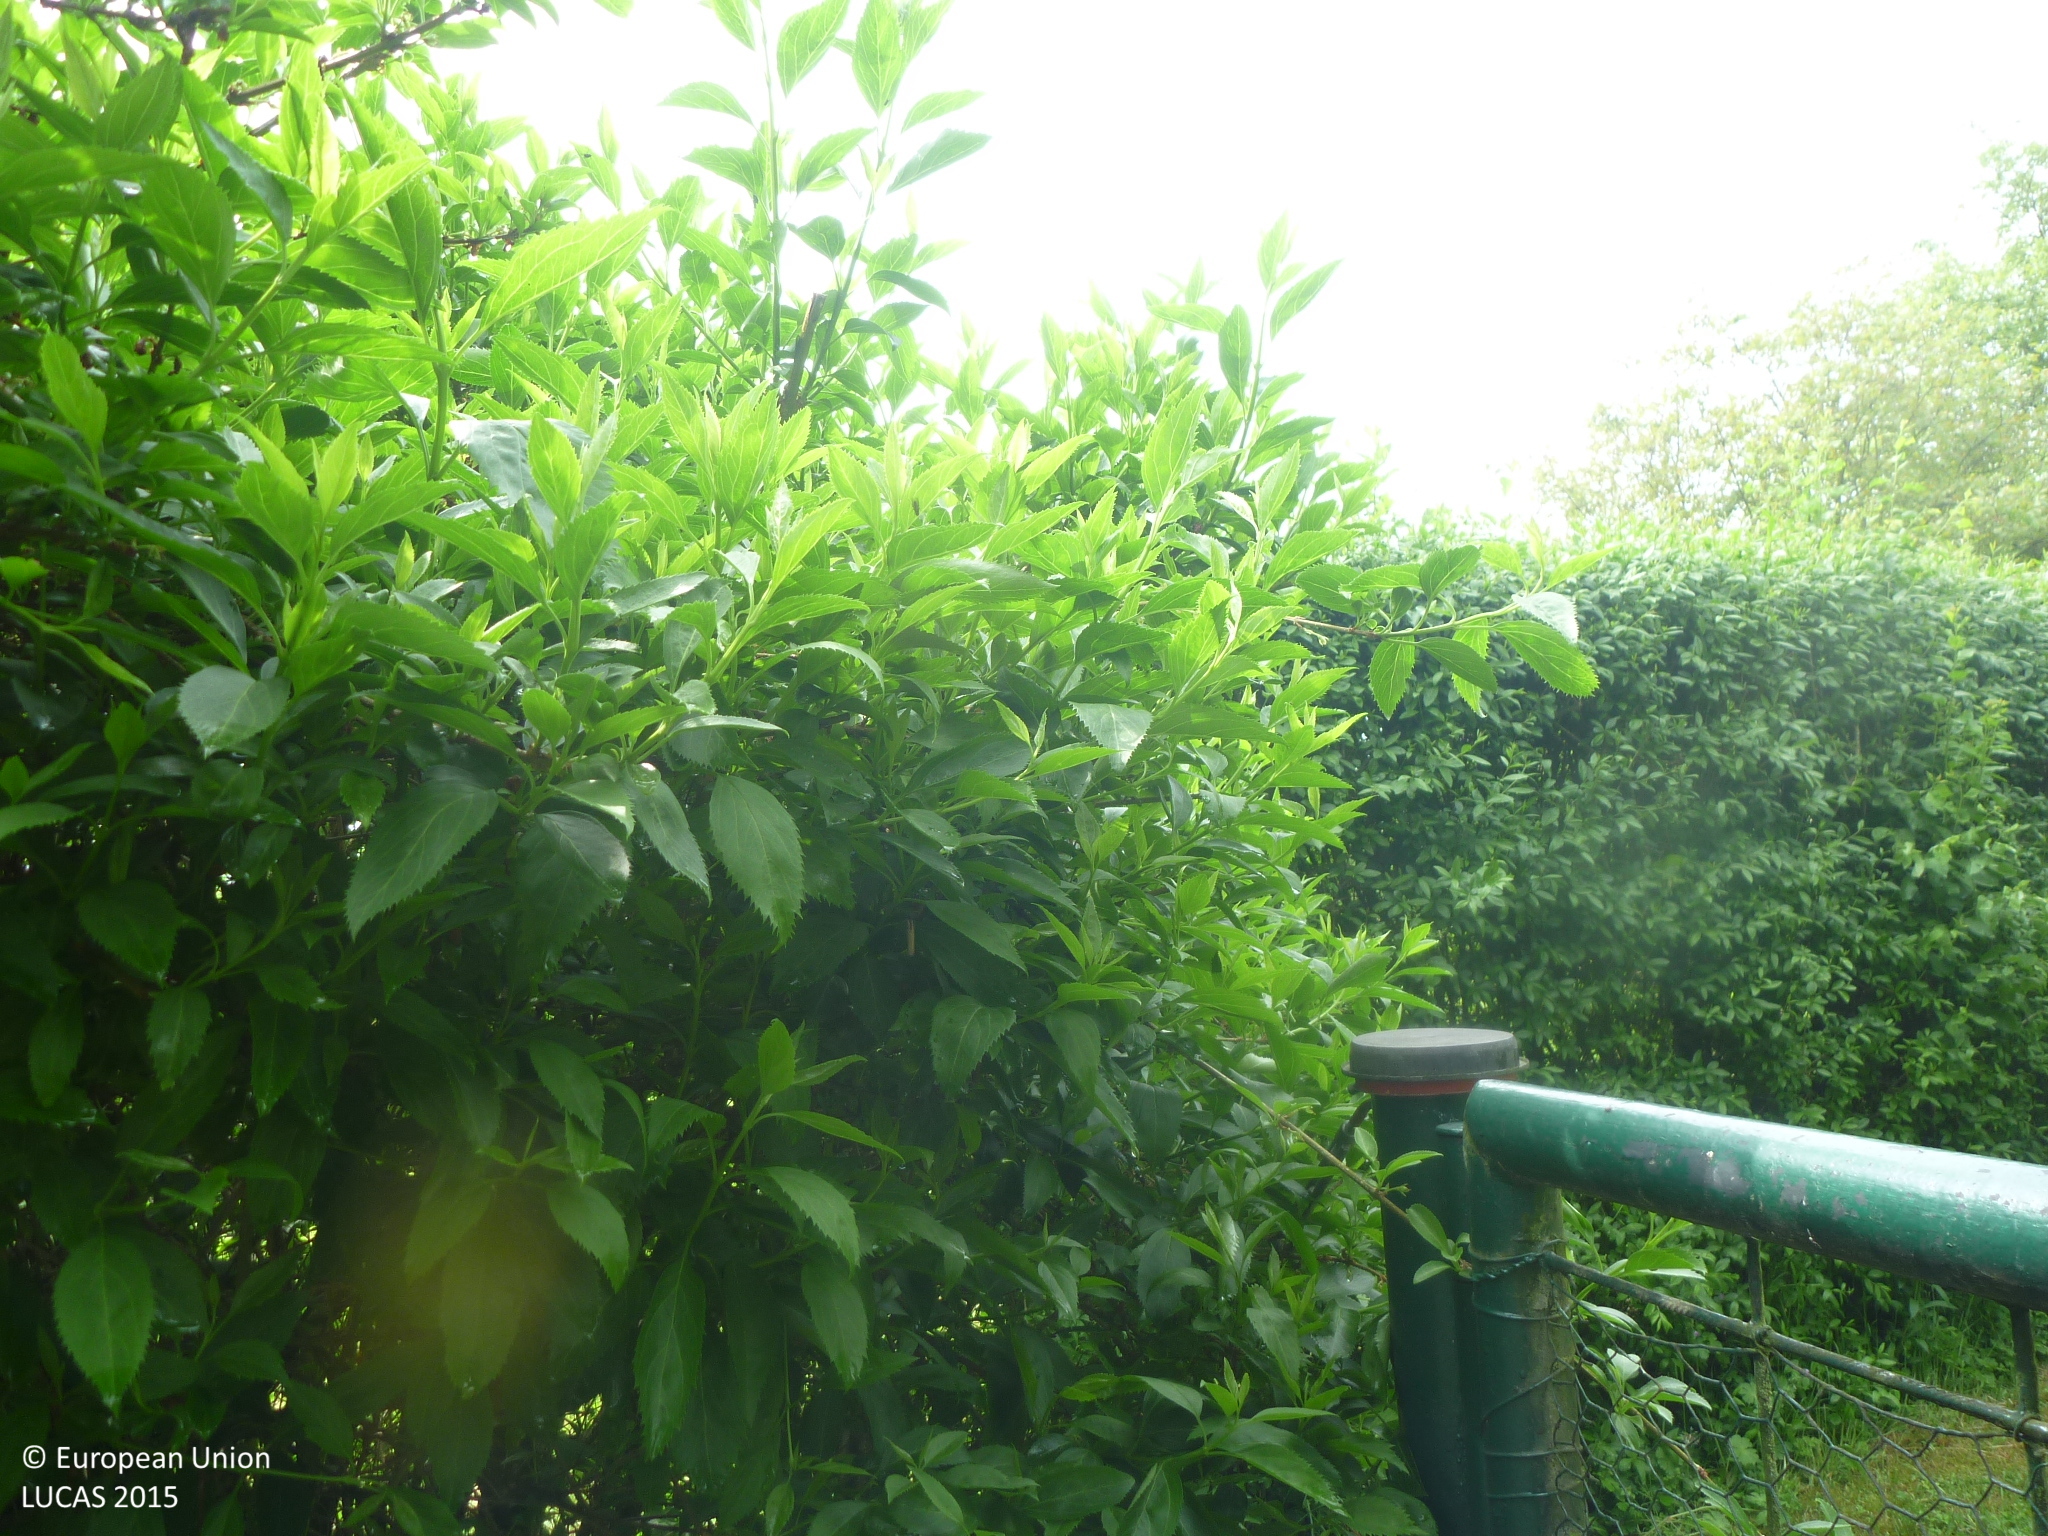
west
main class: Grassland
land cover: Grassland with sparse tree/shrub cover
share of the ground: 50 - 75 %
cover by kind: herbaceous plants 90 %, broadleaved forest trees 5 %, shrubs 5 %
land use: Amenities, museums, leisure
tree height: < 5 m
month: May
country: DE
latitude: 48.7975
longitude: 9.3605
